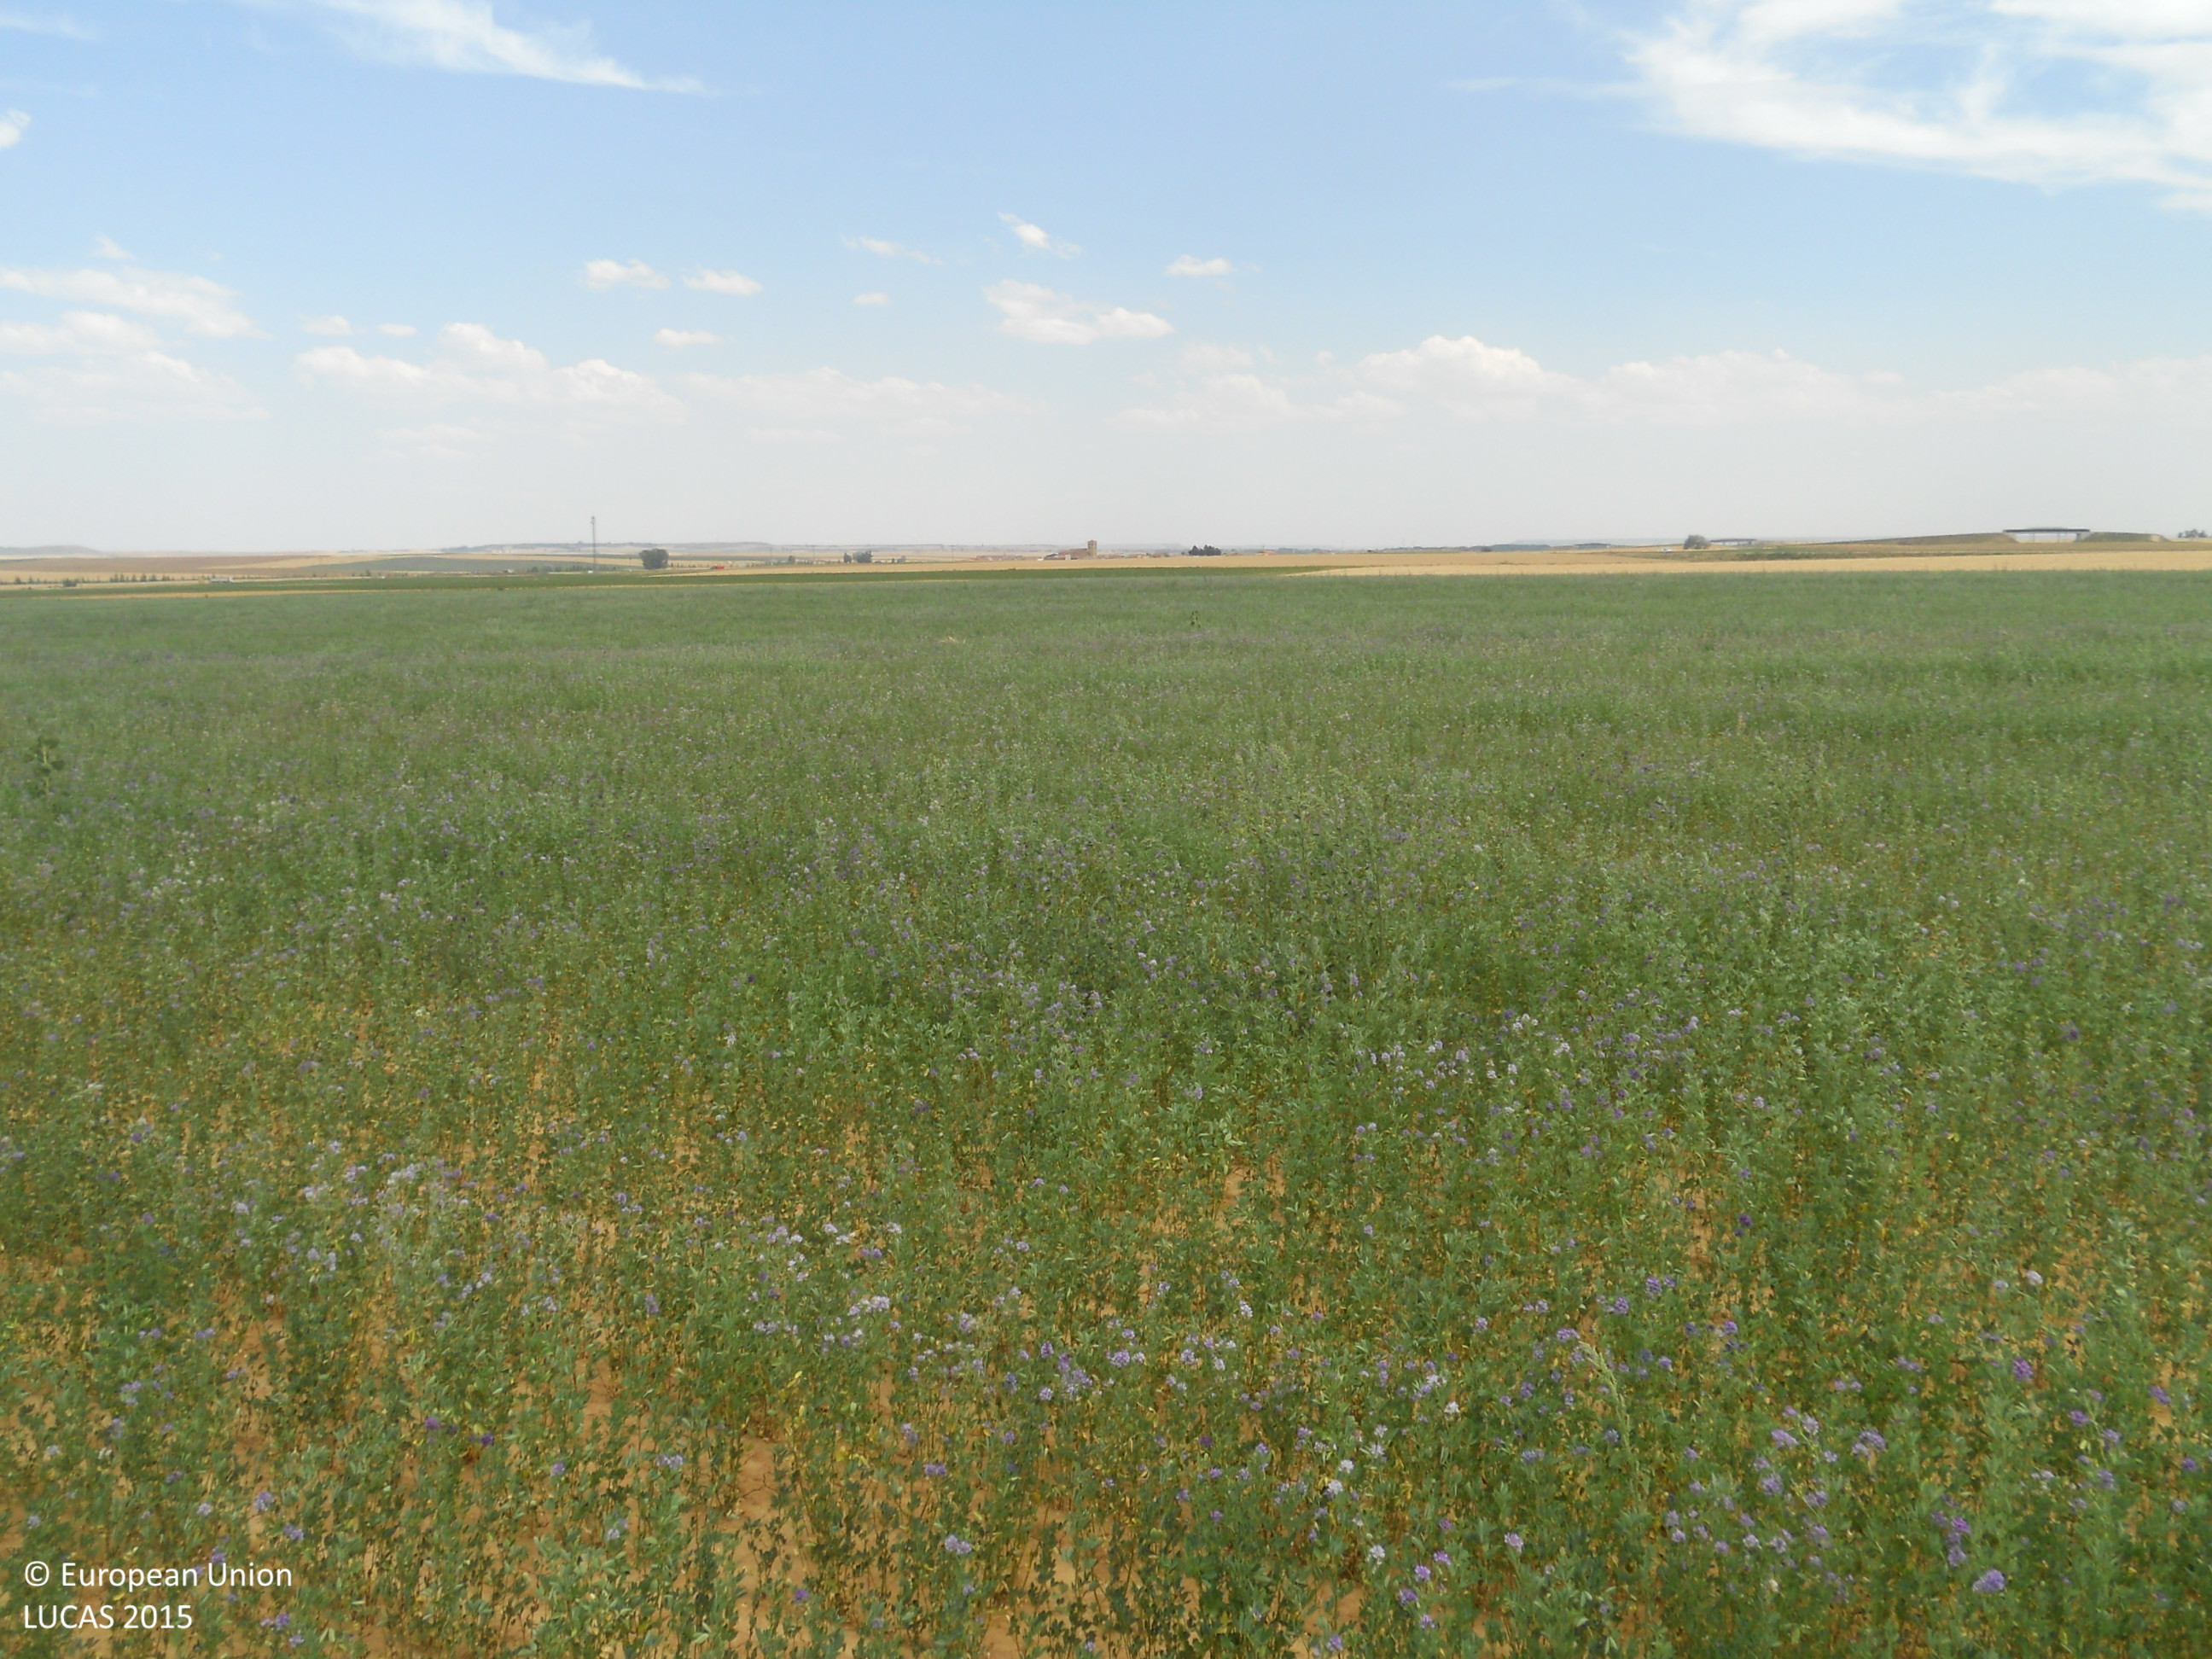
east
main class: Cropland
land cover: Lucerne
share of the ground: > 75 %
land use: Agriculture (excluding fallow land and kitchen gardens)
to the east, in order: Lucerne
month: July
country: ES
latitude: 42.2025
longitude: -4.7923
